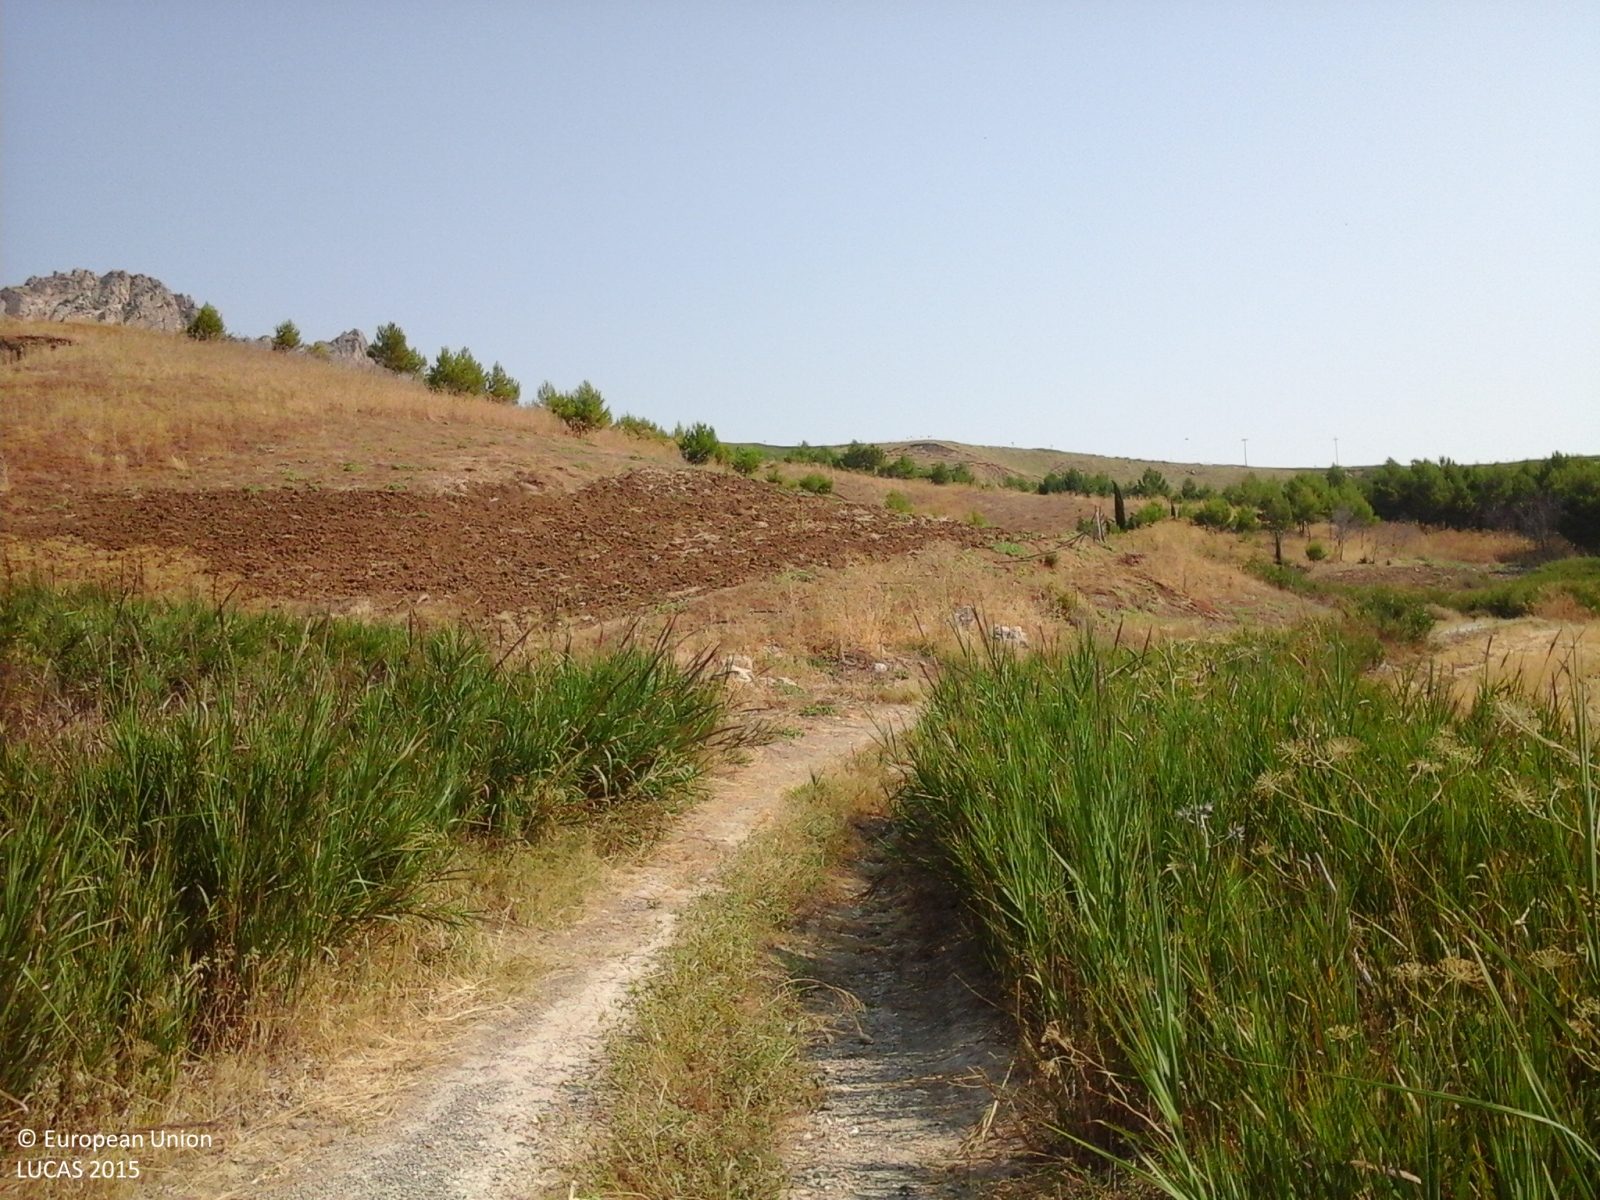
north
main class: Woodland
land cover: Other coniferous woodland
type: coniferous forest of the mediterranean region
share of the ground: > 75 %
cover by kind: coniferous forest trees 100 %
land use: Semi-natural and natural areas not in use
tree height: > 5 m
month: July
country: IT
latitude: 37.2084
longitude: 14.0138
